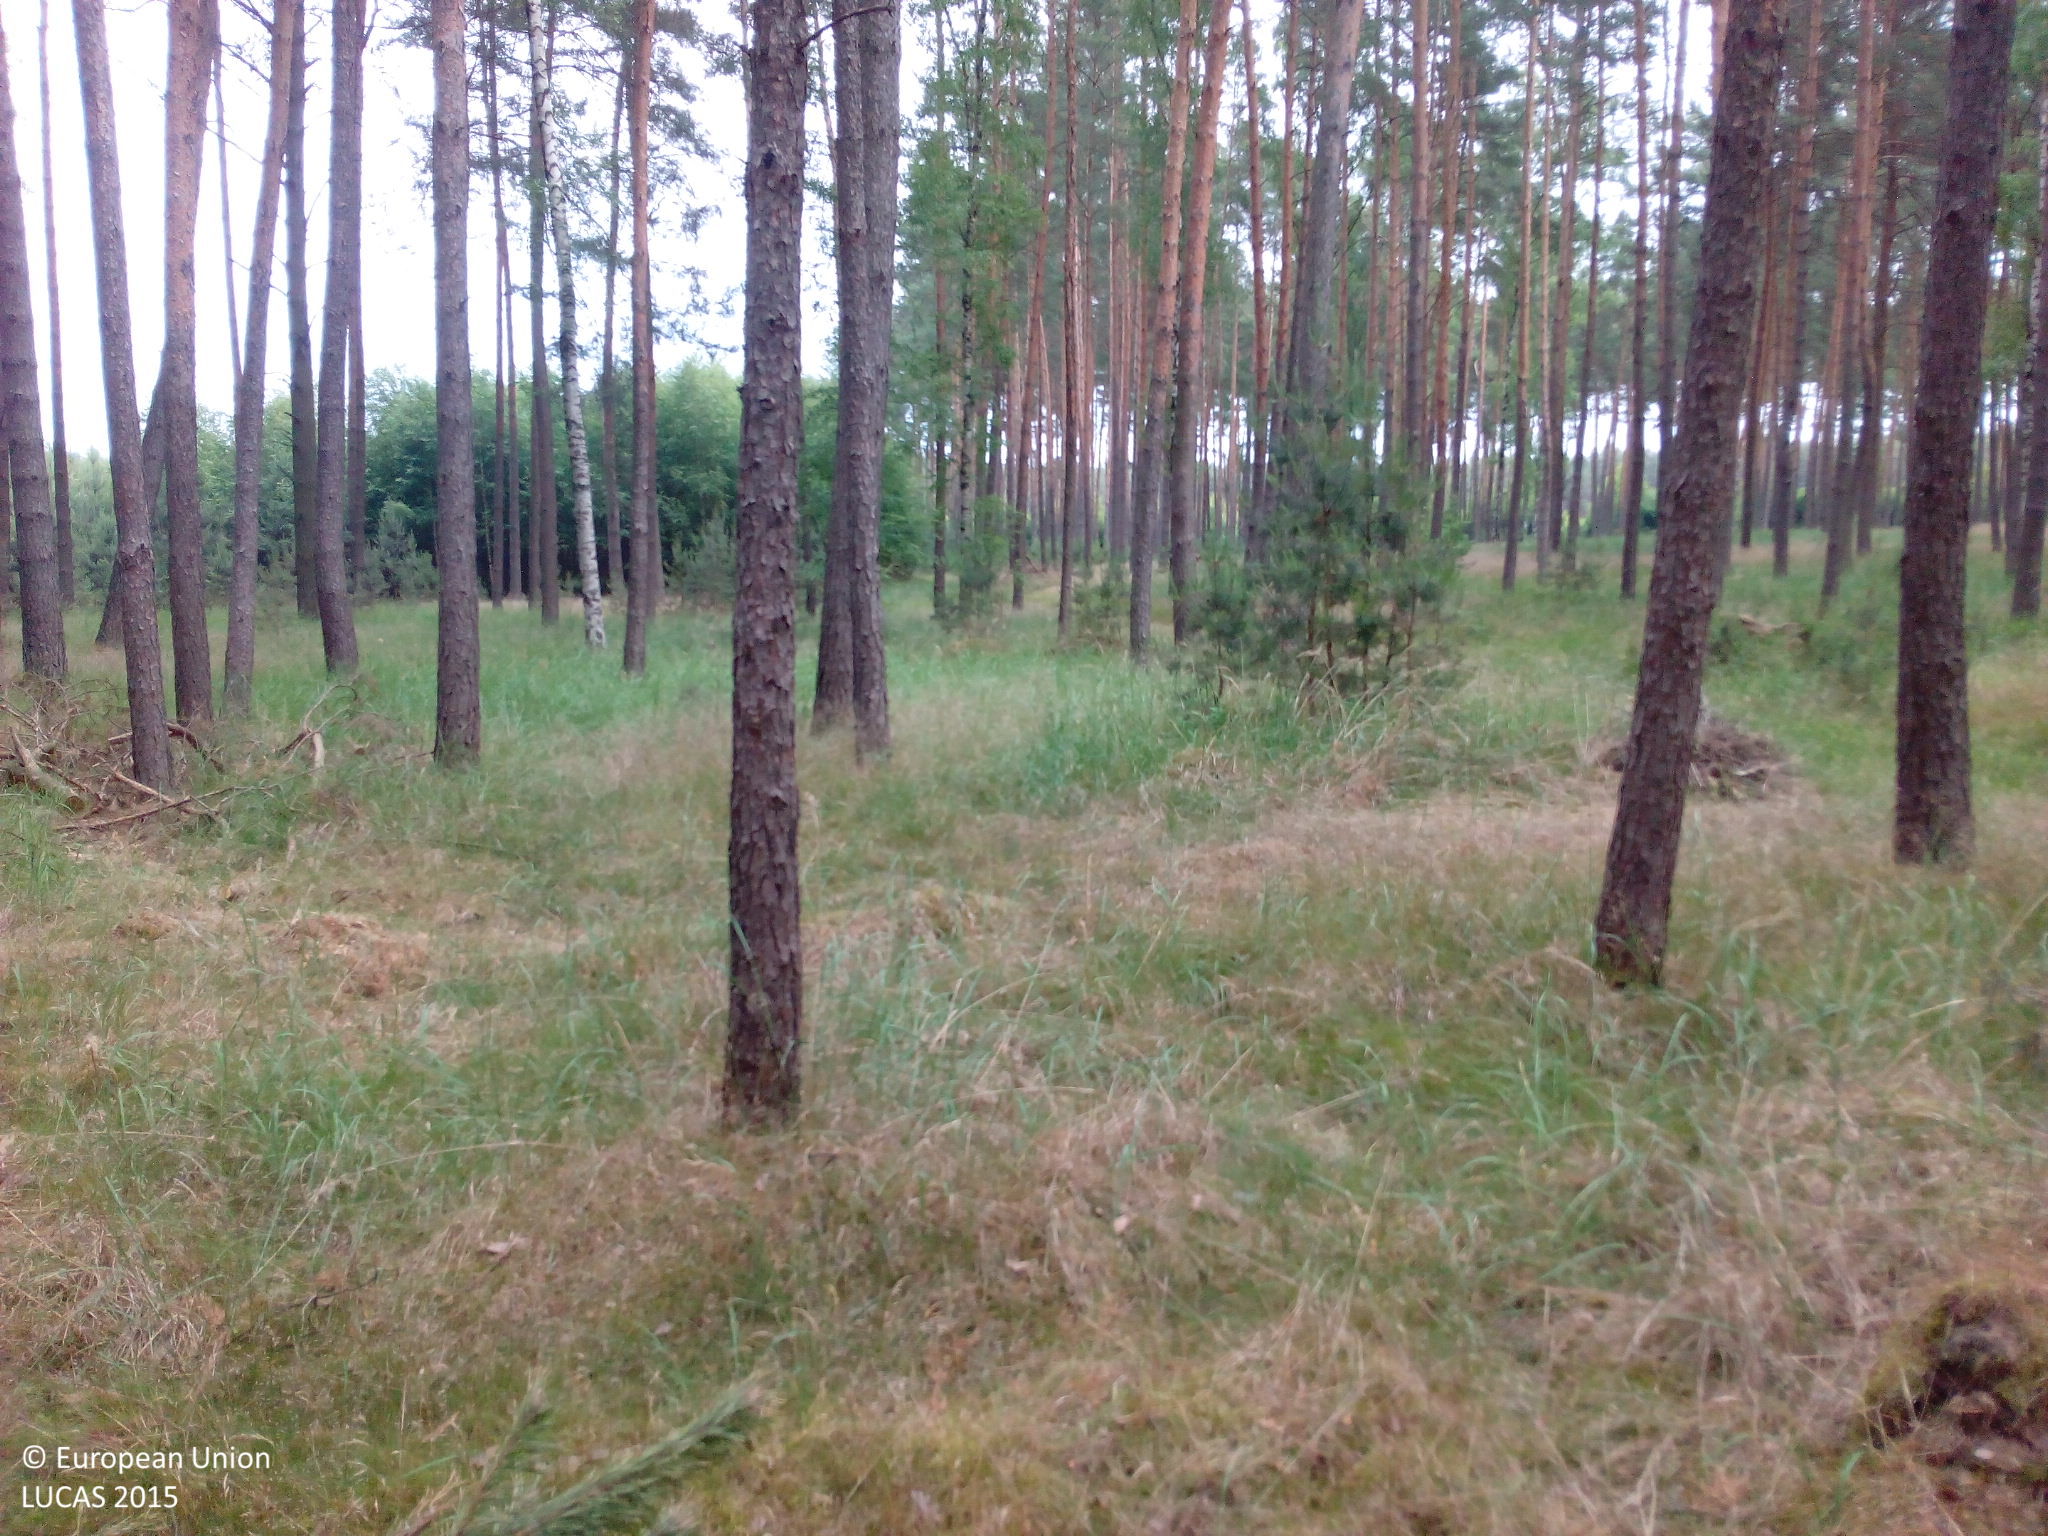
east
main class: Woodland
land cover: Pine dominated coniferous woodland
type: hemiboreal forest and nemoral coniferous forest and mixed broadleaved-coniferous forest
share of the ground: > 75 %
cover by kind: coniferous forest trees 80 %, lichens and mosses 15 %, herbaceous plants 5 %
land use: Forestry
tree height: > 5 m
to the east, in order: Pine dominated coniferous woodland; Tracks; Pine dominated coniferous woodland; Tracks; Broadleaved woodland
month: June
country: DE
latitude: 52.1732
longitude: 12.4123
